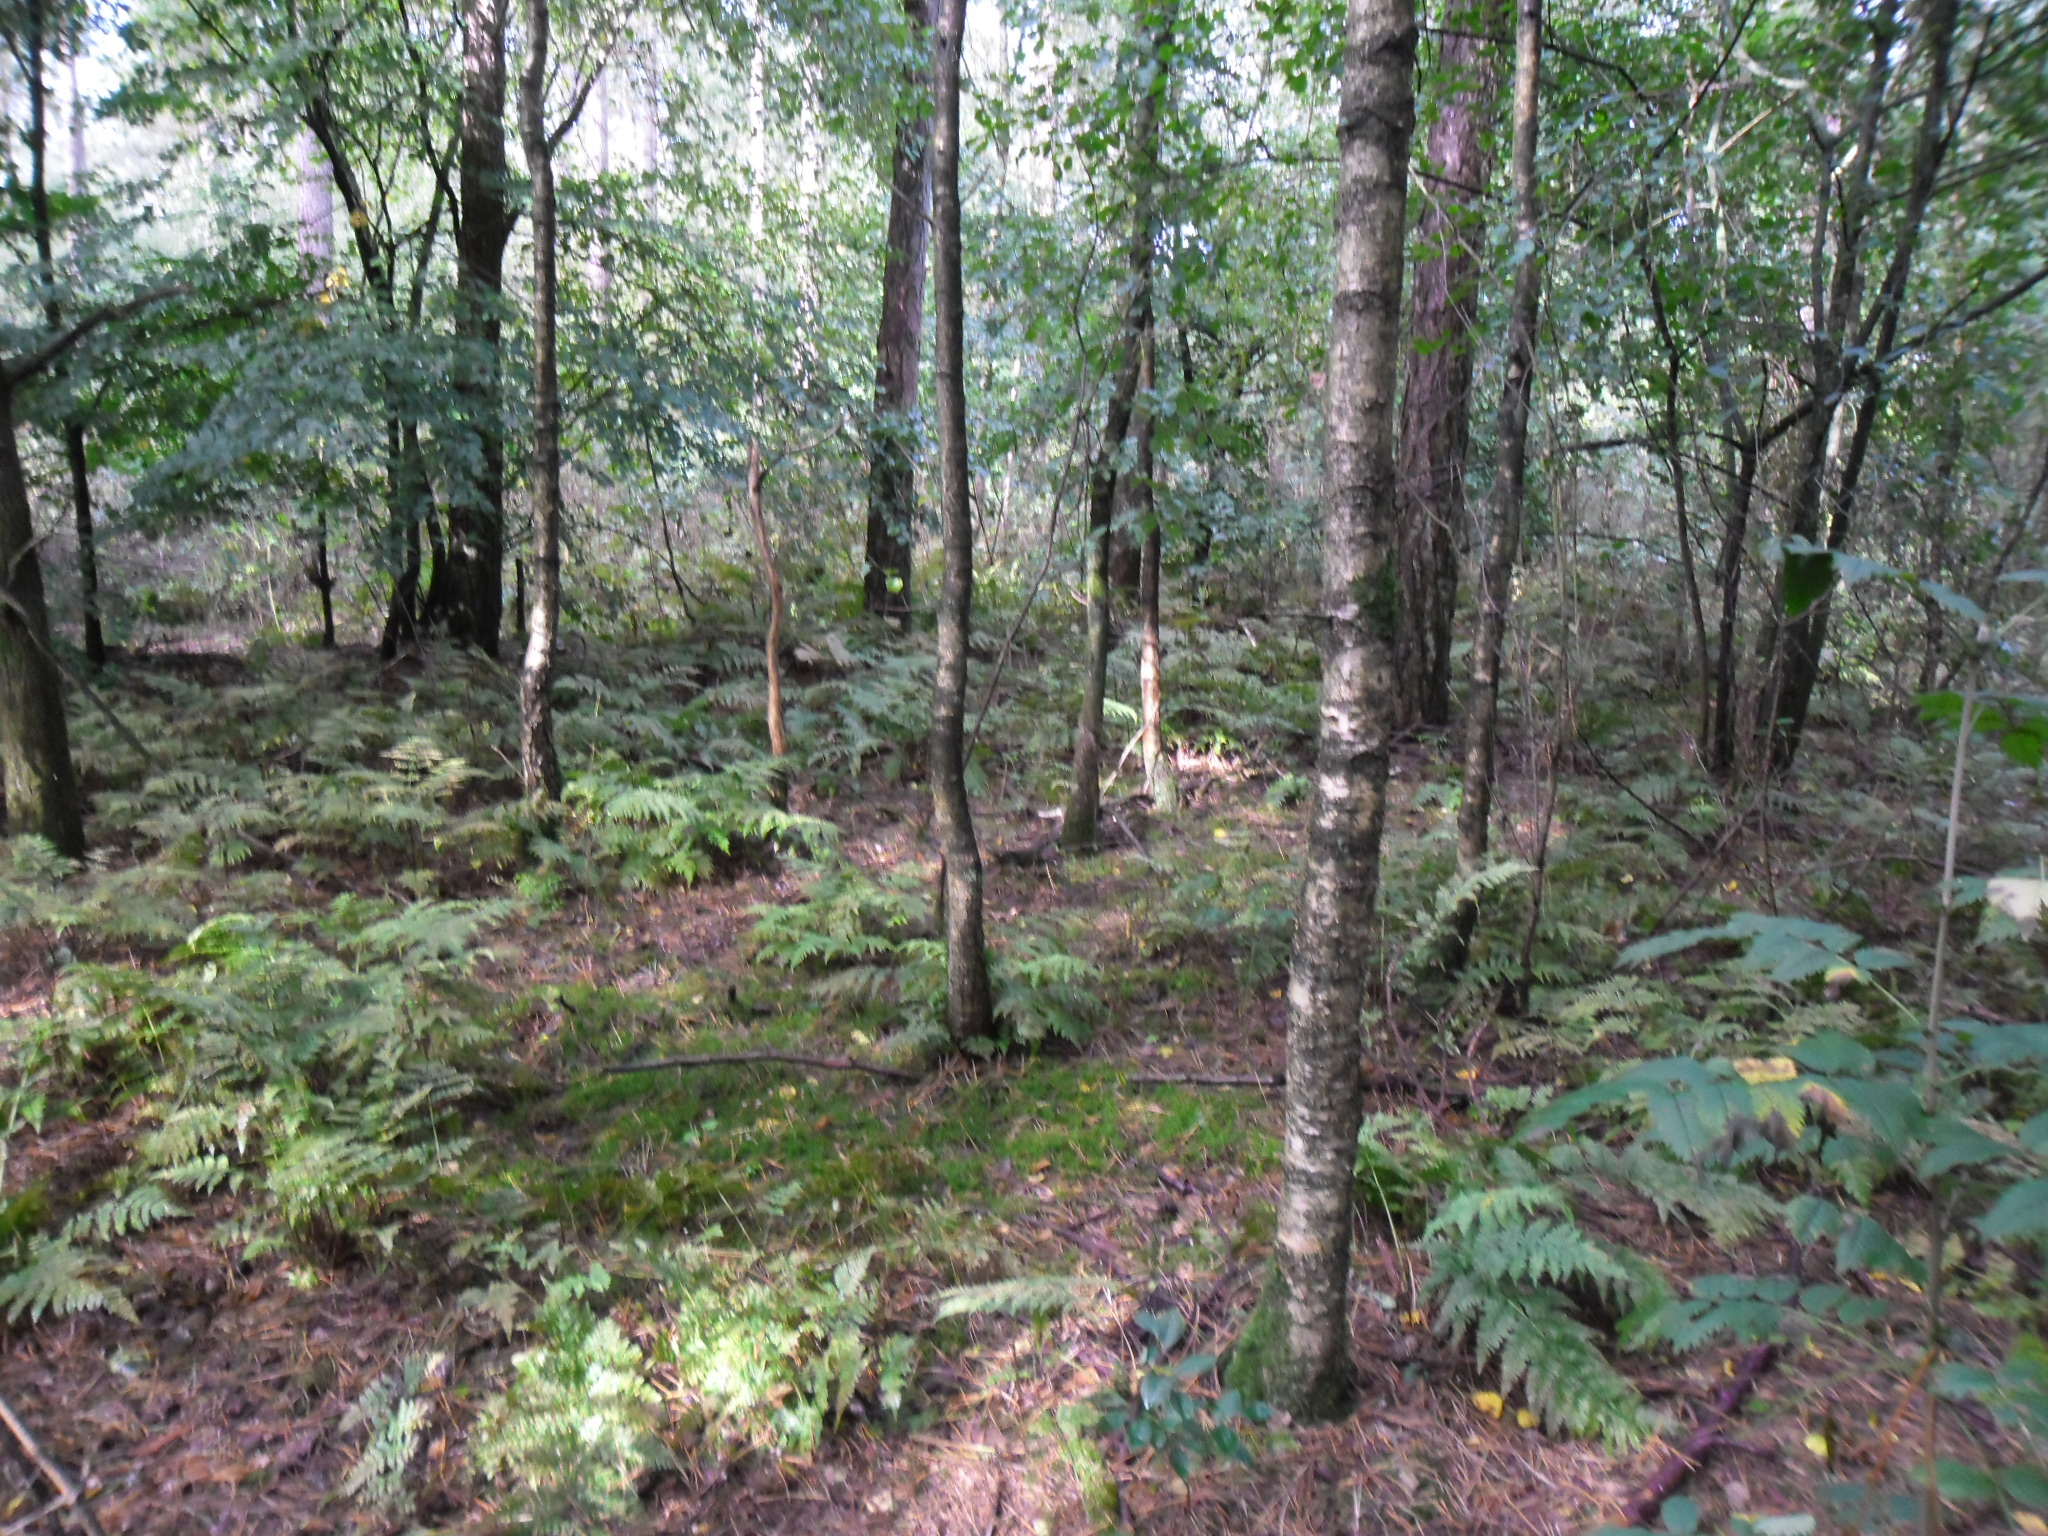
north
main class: Woodland
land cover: Other mixed woodland
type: hemiboreal forest and nemoral coniferous forest and mixed broadleaved-coniferous forest
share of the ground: > 75 %
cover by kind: coniferous forest trees 50 %, broadleaved forest trees 50 %
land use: Forestry
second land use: Amenities, museums, leisure
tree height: > 5 m
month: September
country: NL
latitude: 52.0220
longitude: 5.4952
